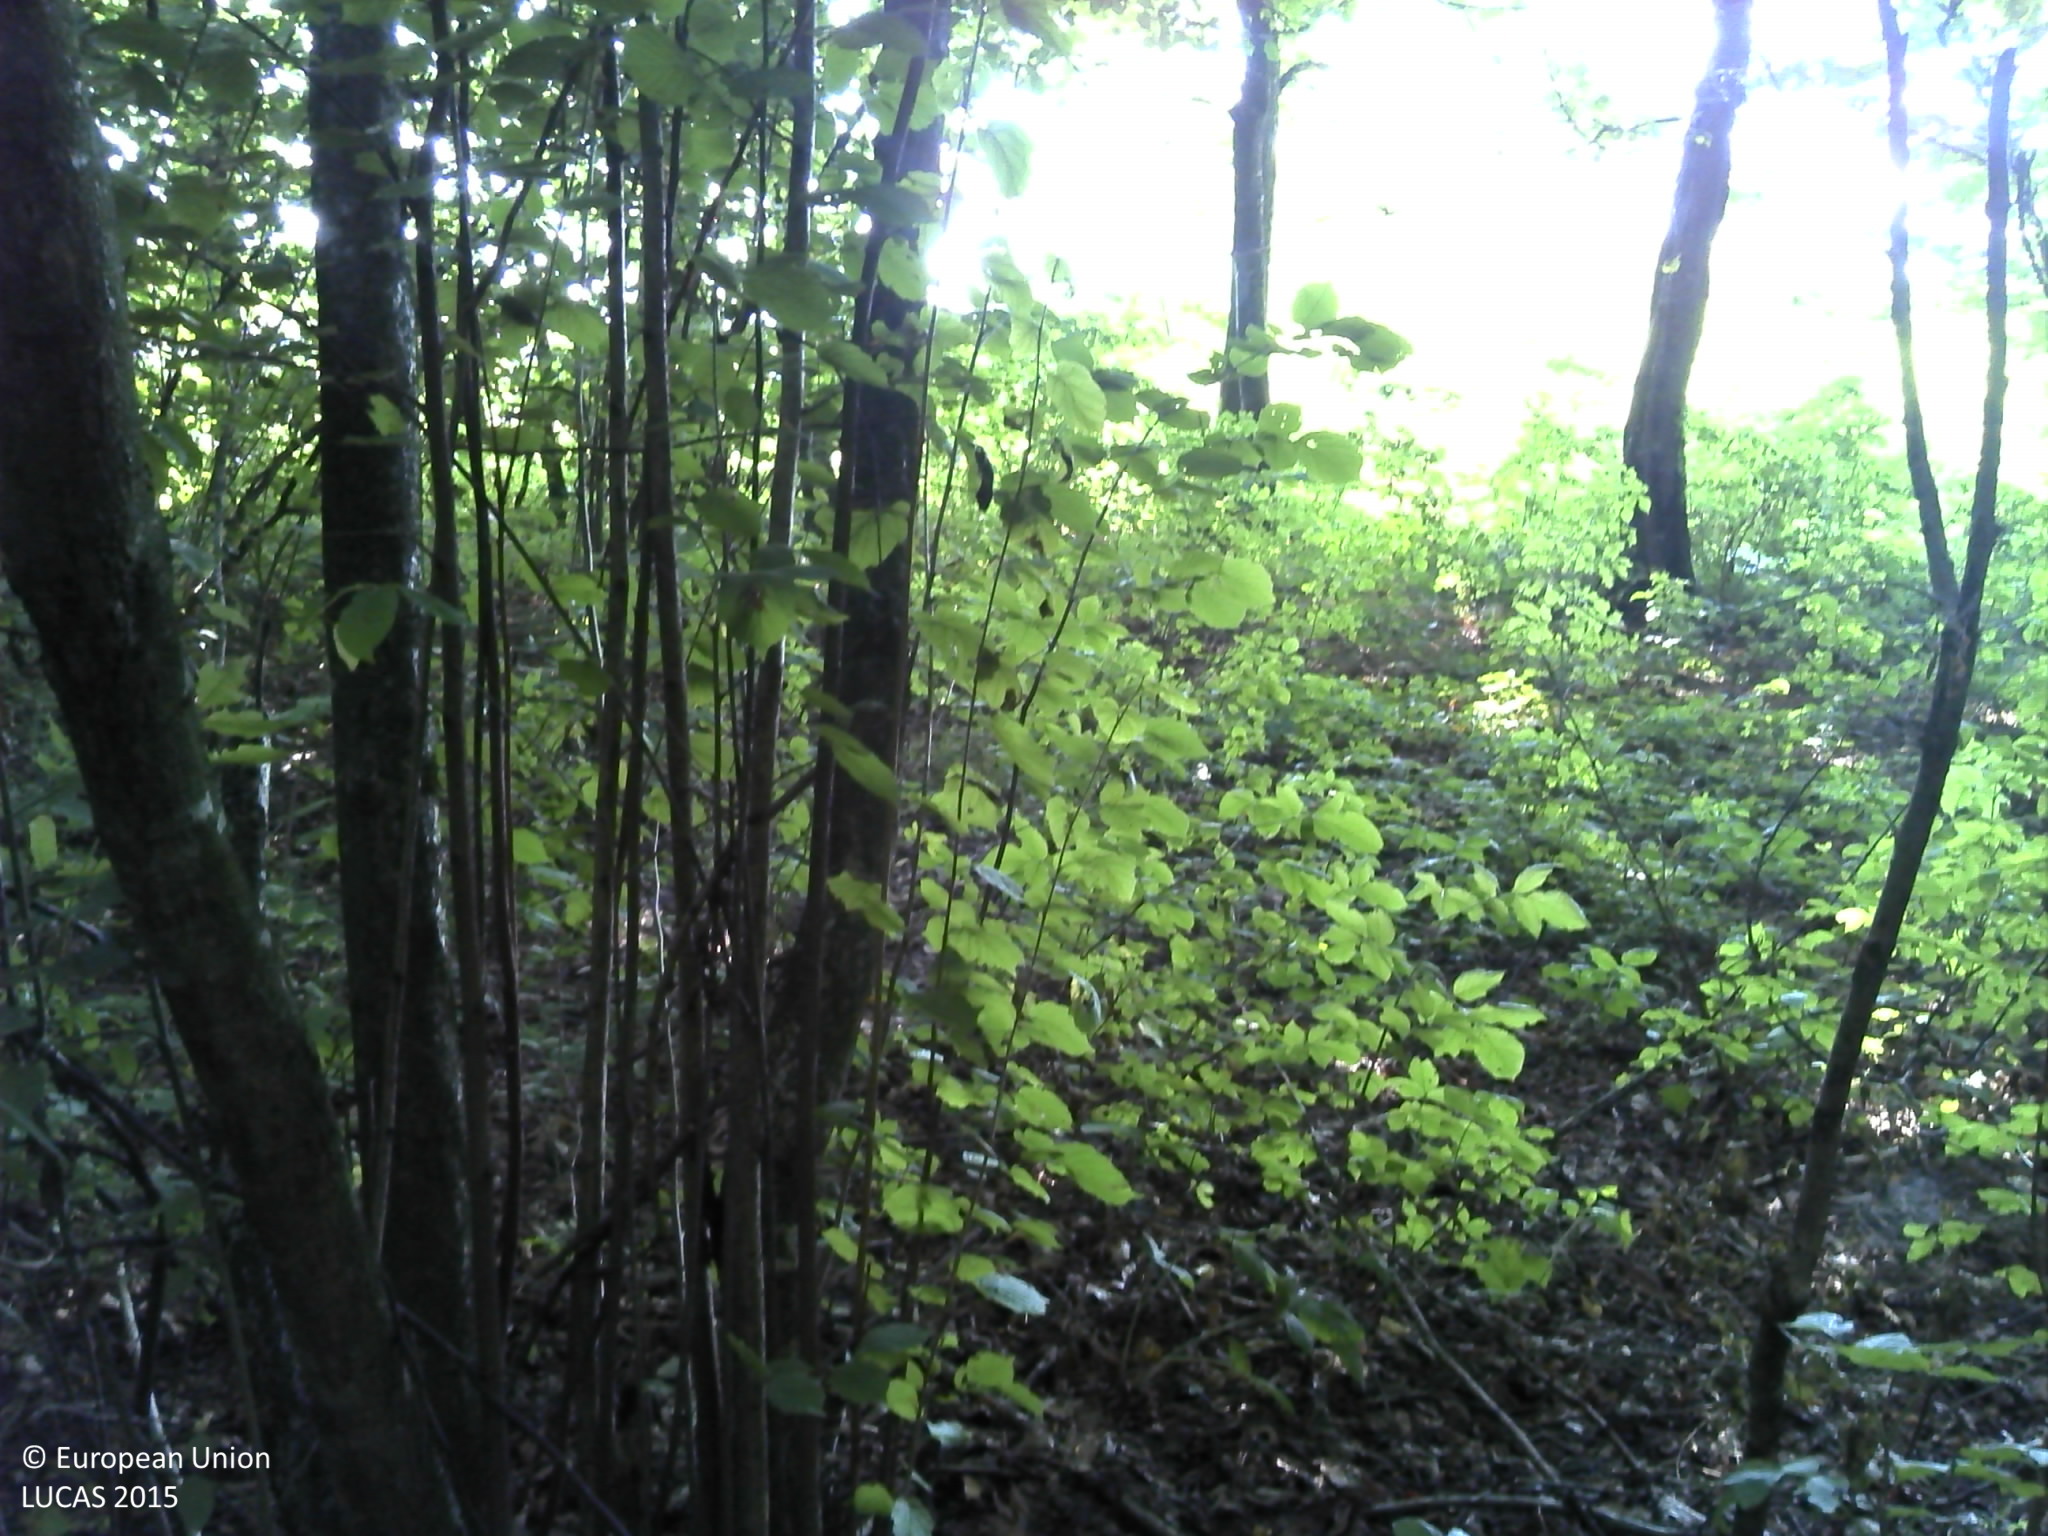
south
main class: Woodland
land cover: Broadleaved woodland
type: beech forest
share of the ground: > 75 %
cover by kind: broadleaved forest trees 100 %
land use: Forestry
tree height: > 5 m
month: August
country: HR
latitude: 45.5453
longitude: 17.2371
